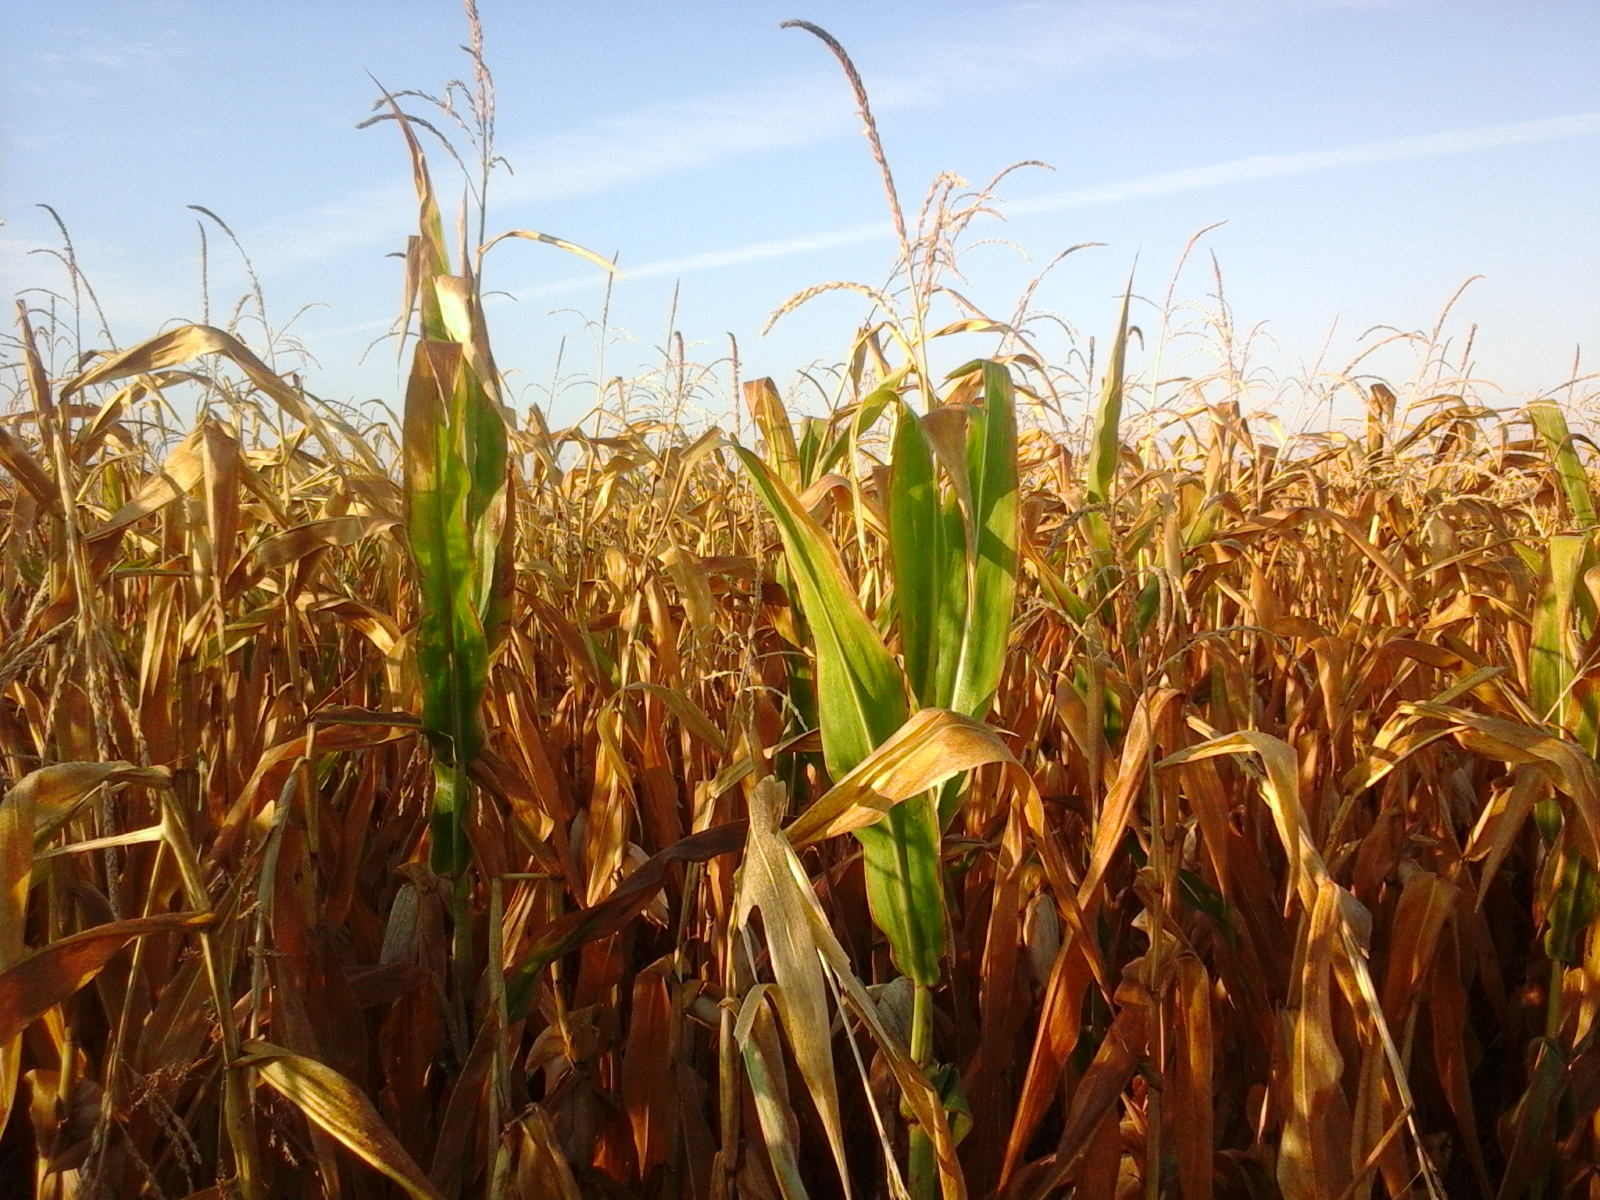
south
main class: Cropland
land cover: Maize
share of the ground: > 75 %
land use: Agriculture (excluding fallow land and kitchen gardens)
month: August
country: RO
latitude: 45.9547
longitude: 21.0870
